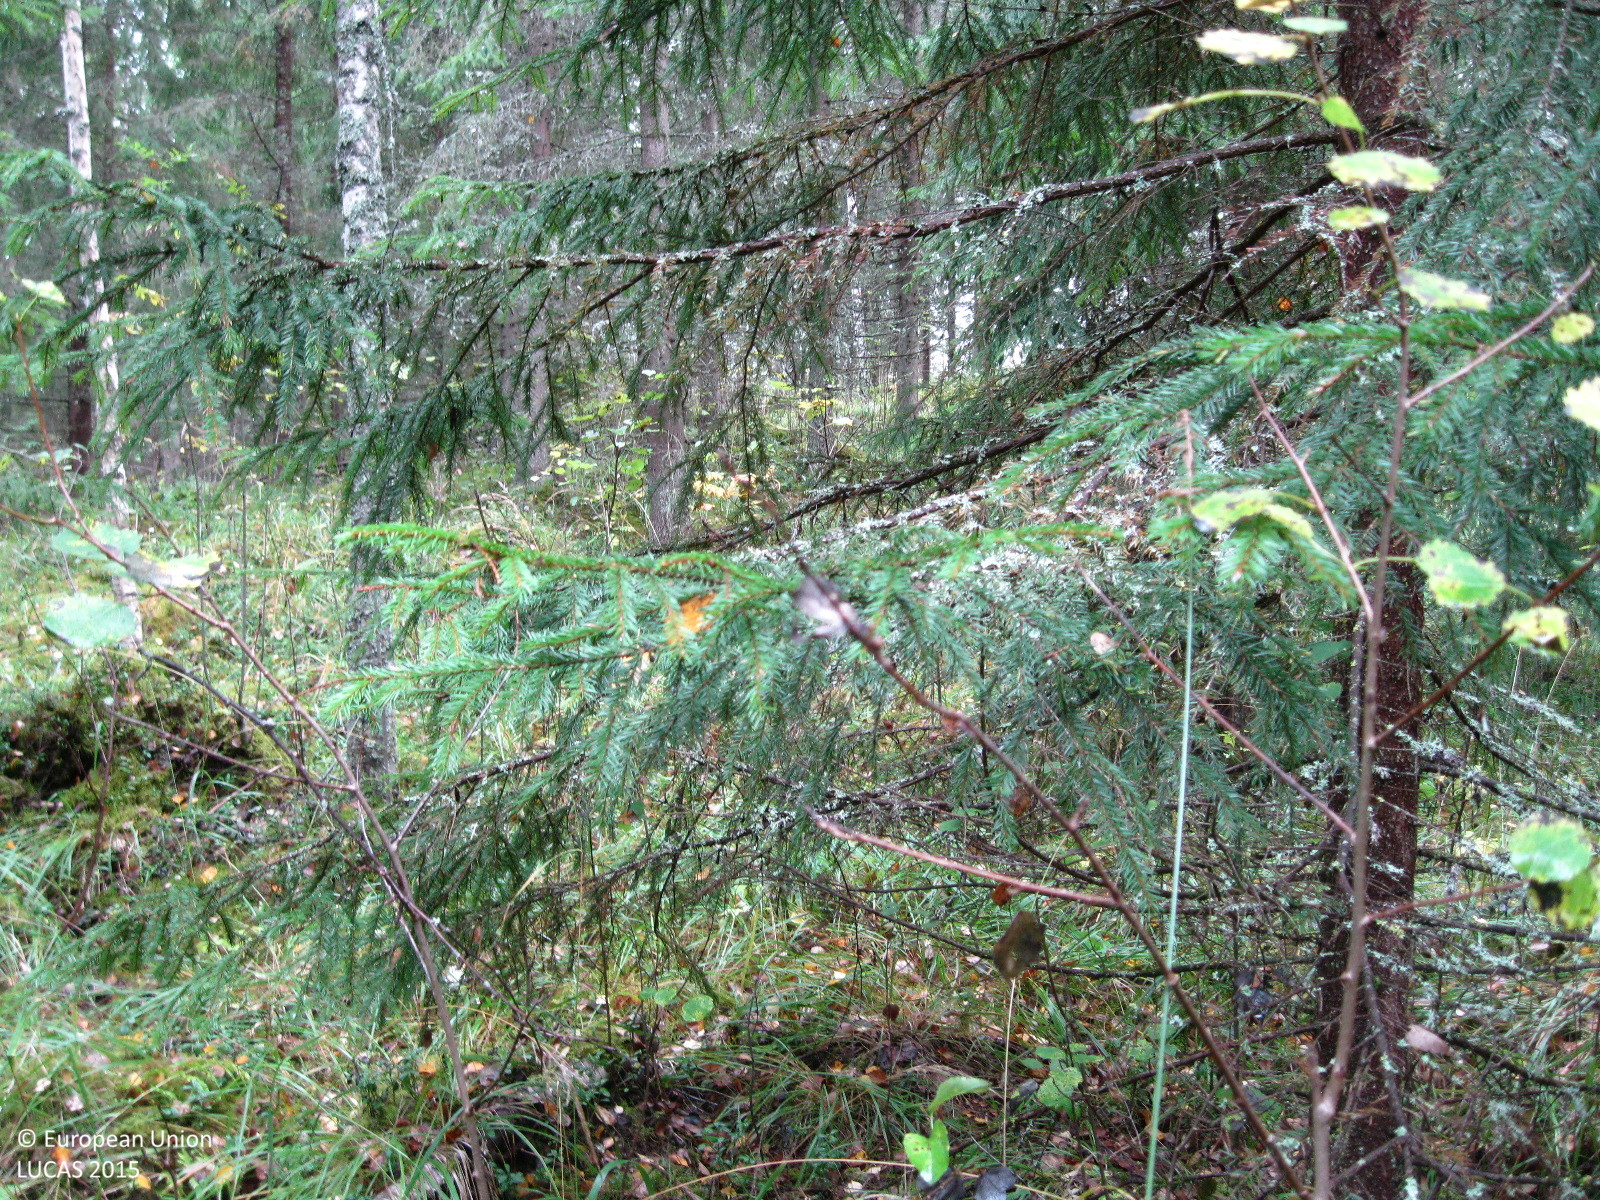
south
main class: Woodland
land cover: Spruce dominated mixed woodland
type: boreal forest
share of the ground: 50 - 75 %
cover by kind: coniferous forest trees 50 %, broadleaved forest trees 20 %, herbaceous plants 20 %, shrubs 5 %, lichens and mosses 5 %
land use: Forestry
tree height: > 5 m
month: September
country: FI
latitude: 60.8612
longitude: 24.8207
